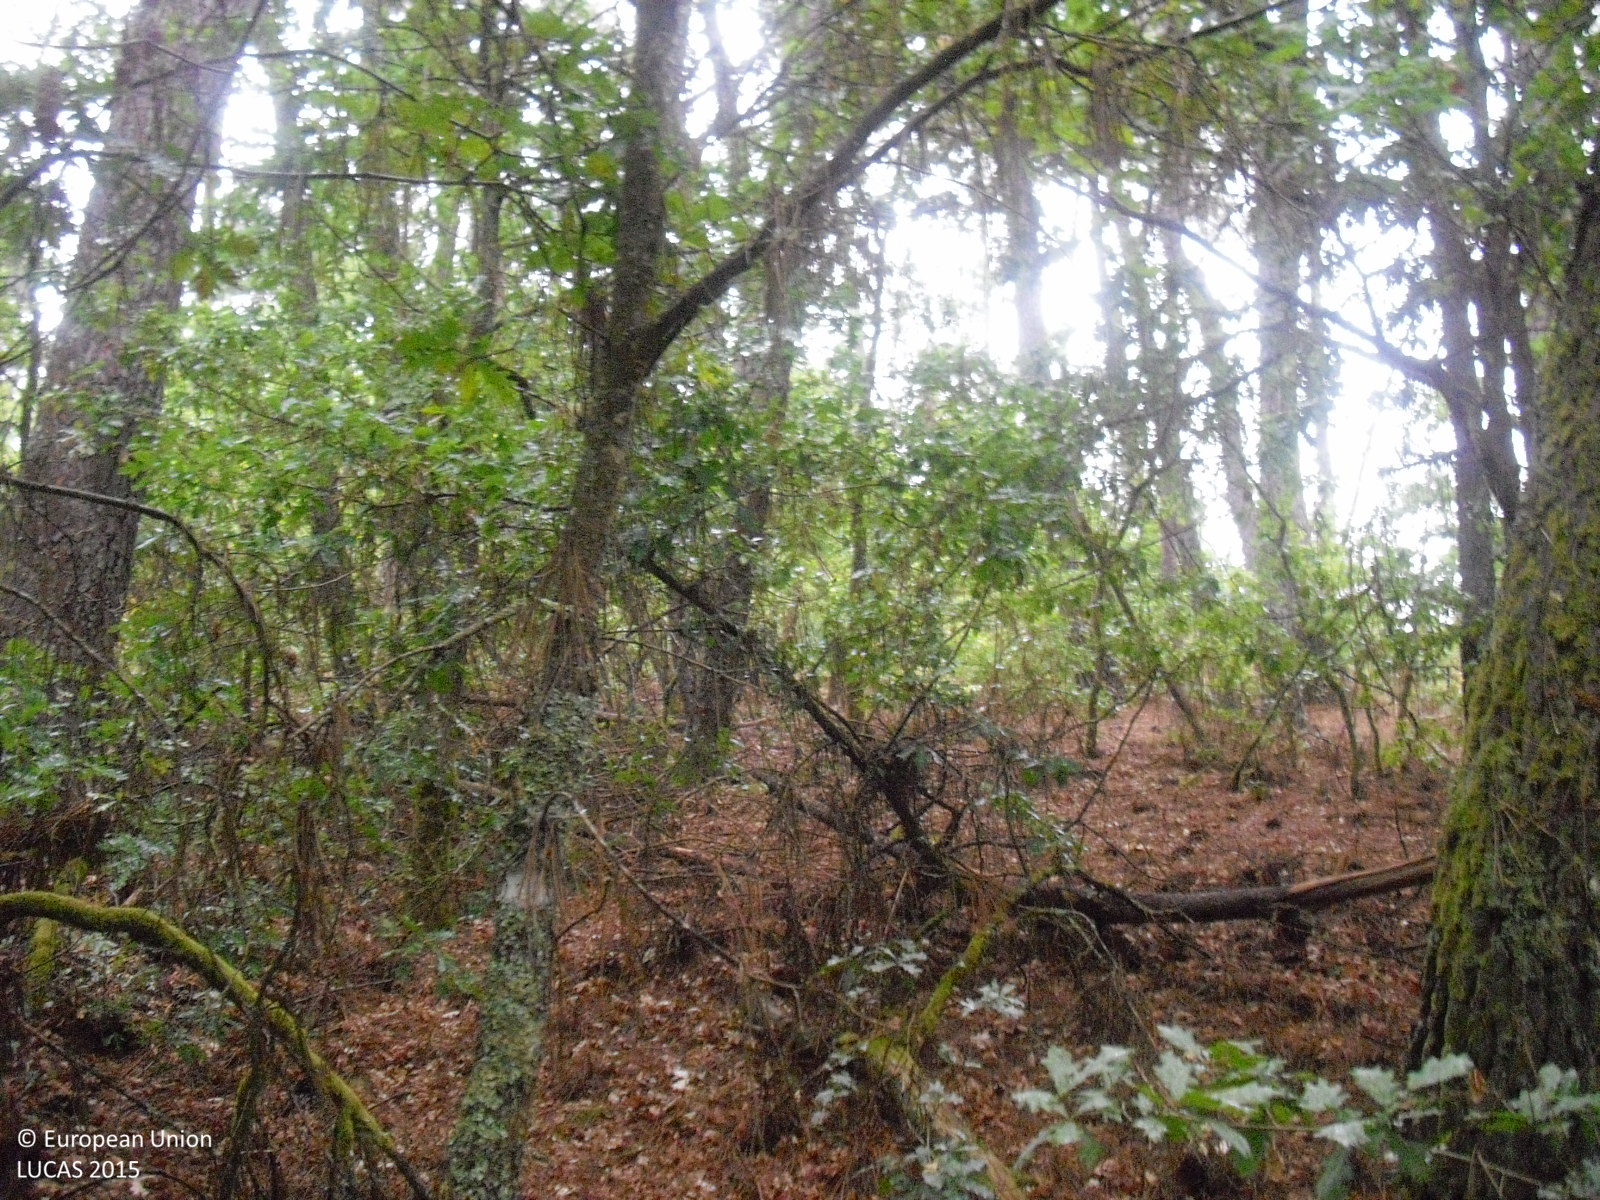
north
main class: Woodland
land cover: Pine dominated mixed woodland
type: hemiboreal forest and nemoral coniferous forest and mixed broadleaved-coniferous forest
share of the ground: > 75 %
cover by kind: coniferous forest trees 60 %, broadleaved forest trees 20 %, shrubs 20 %
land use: Forestry
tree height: > 5 m
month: July
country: ES
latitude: 42.3026
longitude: -7.6725
